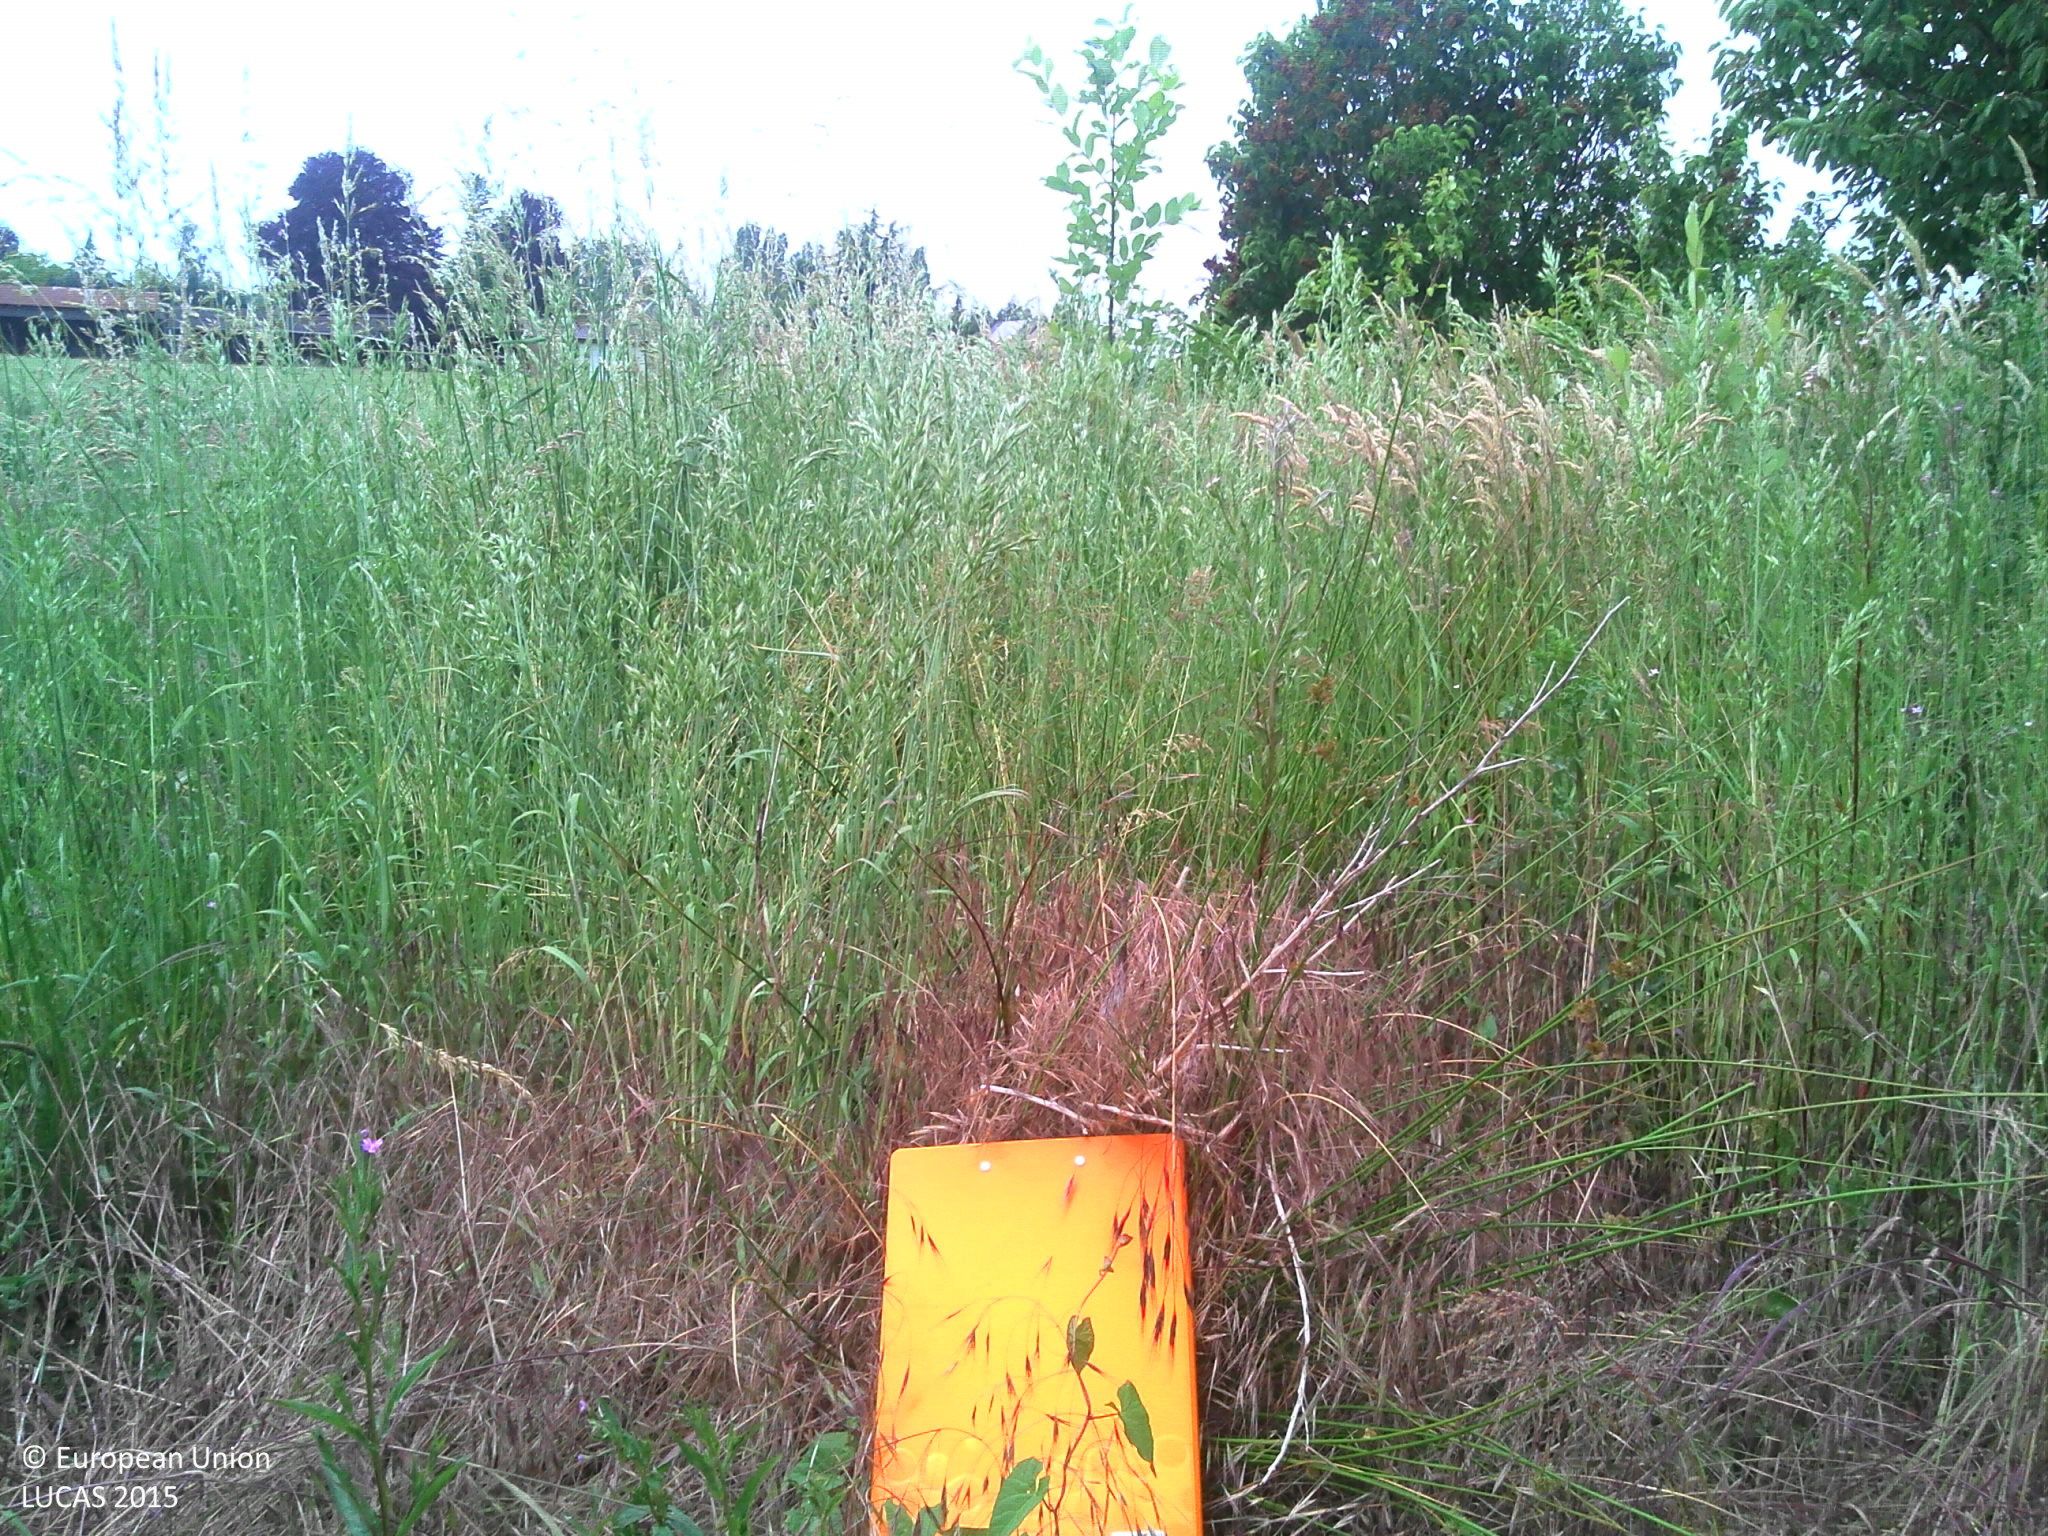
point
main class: Grassland
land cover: Grassland without tree/shrub cover
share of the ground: > 75 %
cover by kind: herbaceous plants 95 %, shrubs 5 %
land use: Agriculture (excluding fallow land and kitchen gardens)
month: June
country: BE
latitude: 50.8817
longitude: 4.5236
